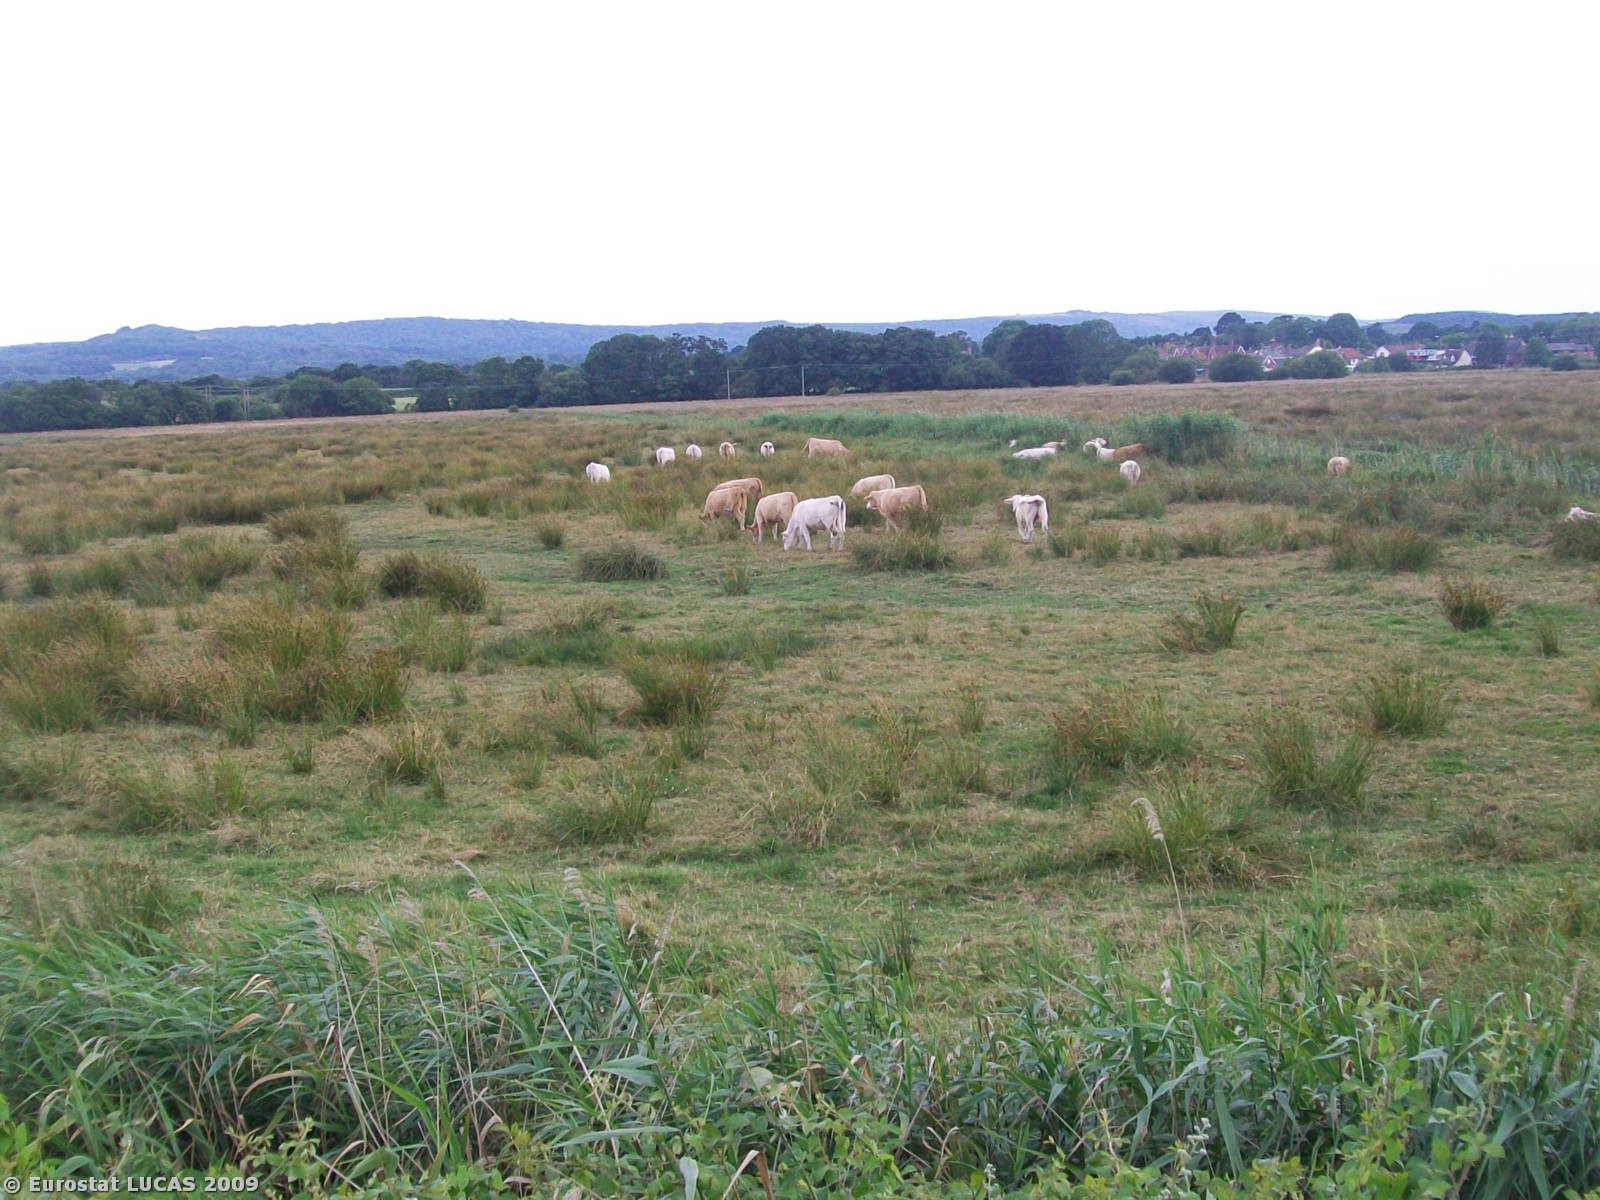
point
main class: Grassland
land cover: Grassland without tree/shrub cover
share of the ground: > 75 %
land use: Agriculture (excluding fallow land and kitchen gardens)
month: July
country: GB
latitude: 50.6823
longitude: -2.1039
